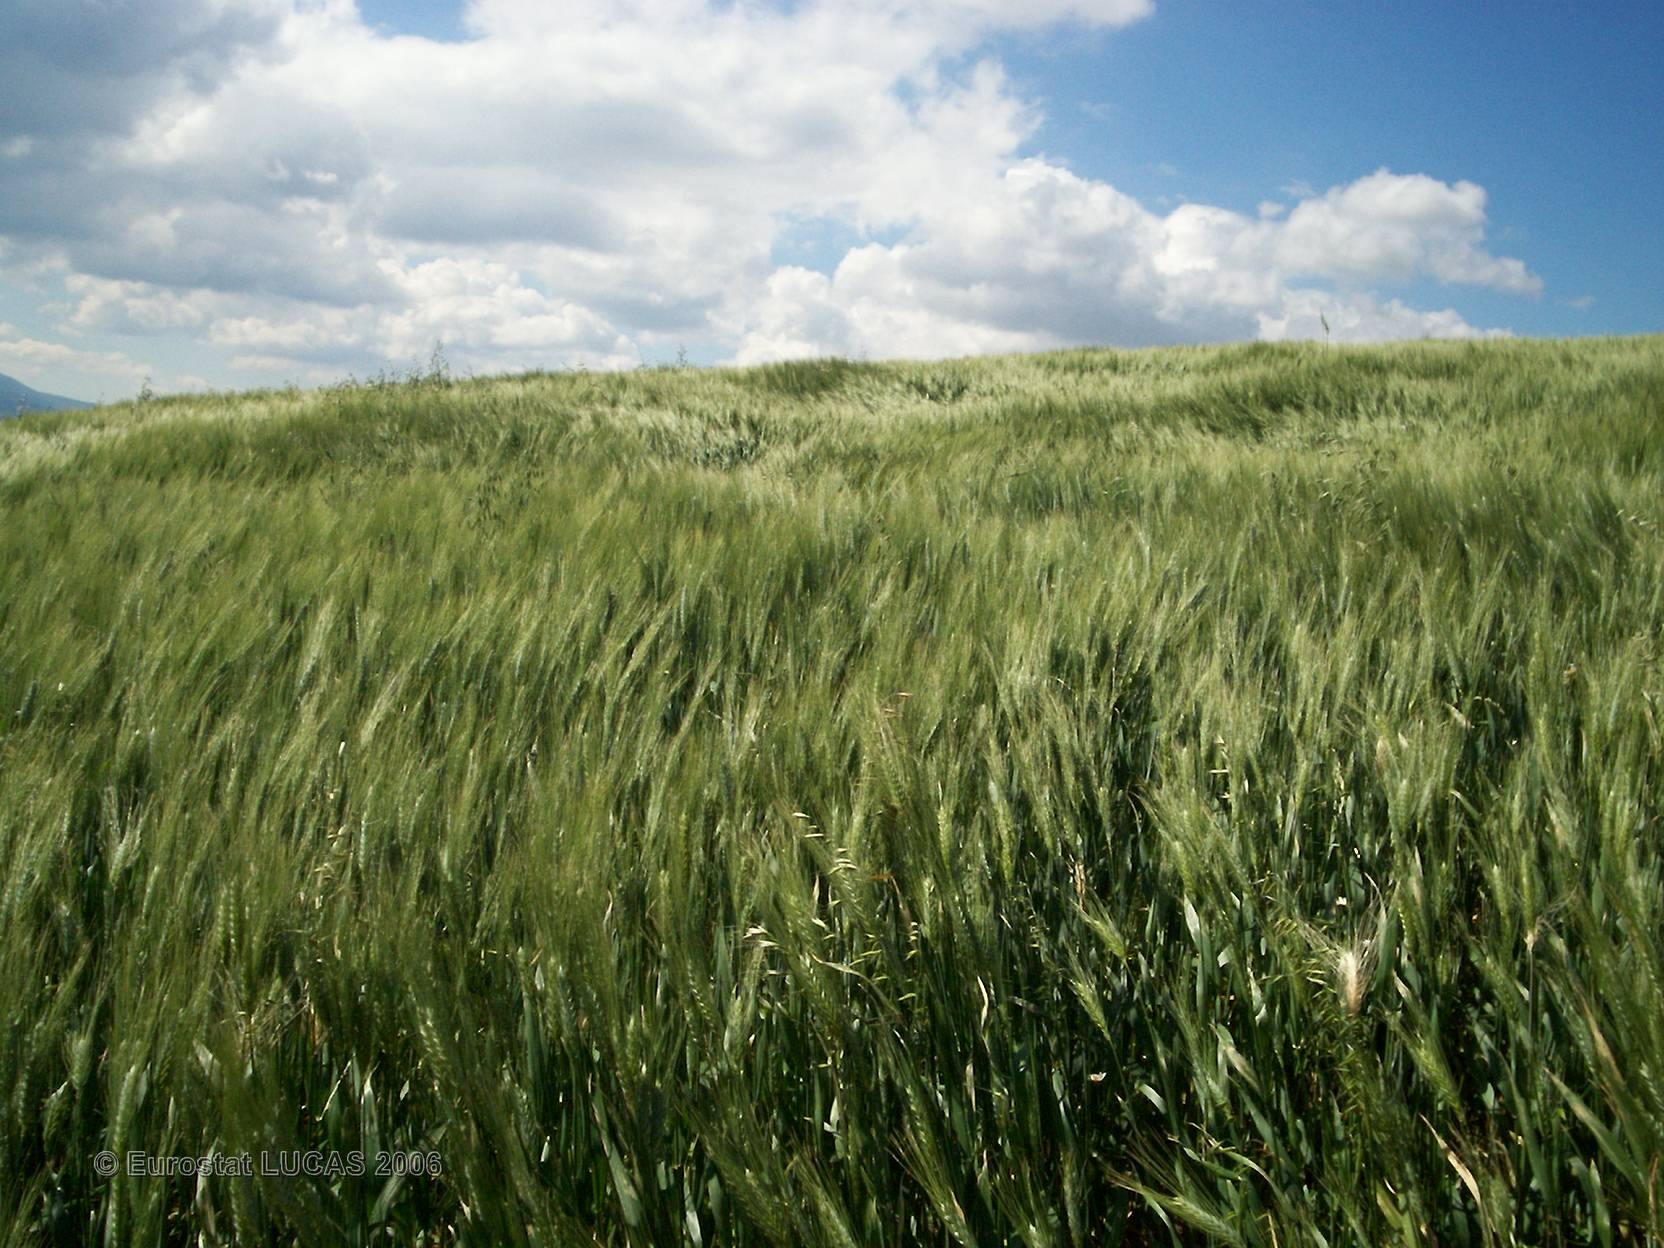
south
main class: Cropland
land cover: Maize
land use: Agriculture (excluding fallow land and kitchen gardens)
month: May
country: FR
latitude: 44.6587
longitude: 4.8989
